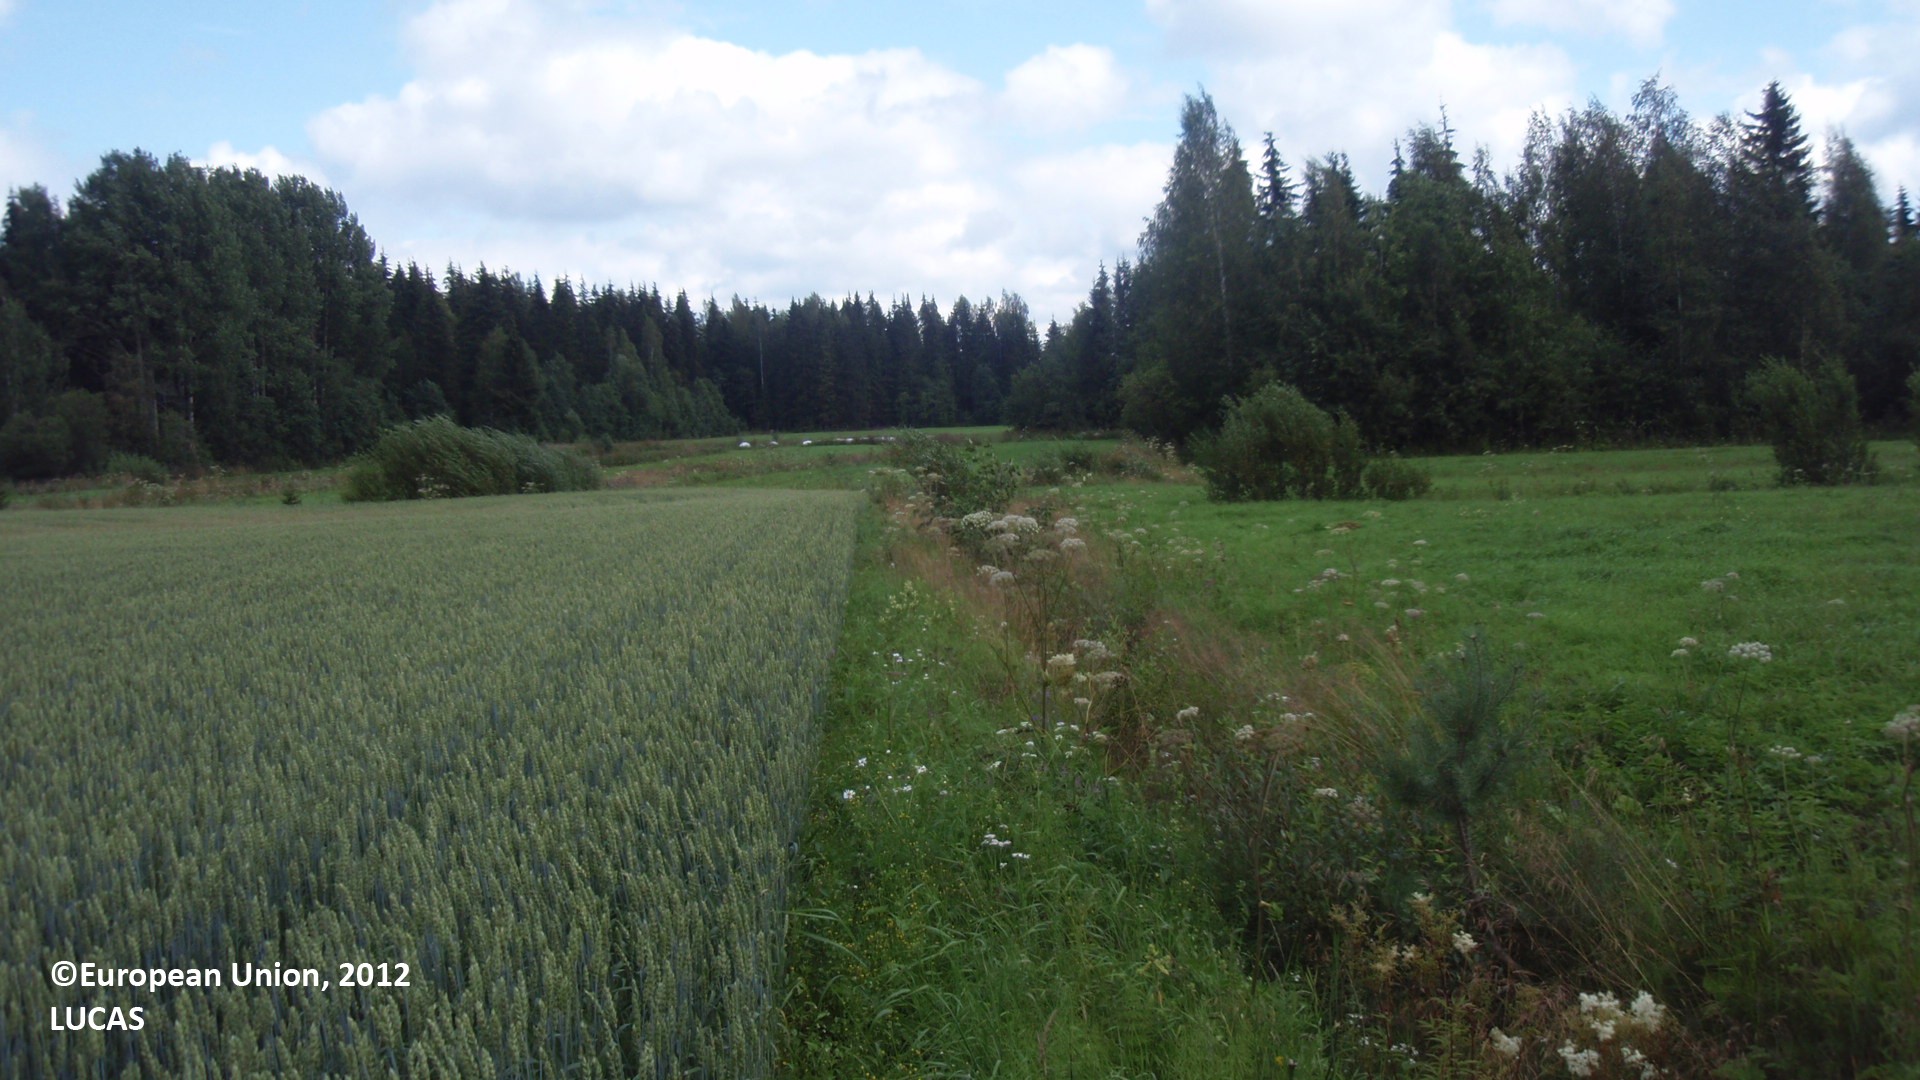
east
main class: Cropland
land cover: Oats
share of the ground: > 75 %
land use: Agriculture (excluding fallow land and kitchen gardens)
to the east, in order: Oats; Grass margins; Ditches and canals; Grass margins; Temporary grasslands; Grass margins; Temporary grasslands
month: July
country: FI
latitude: 60.9667
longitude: 28.4848
